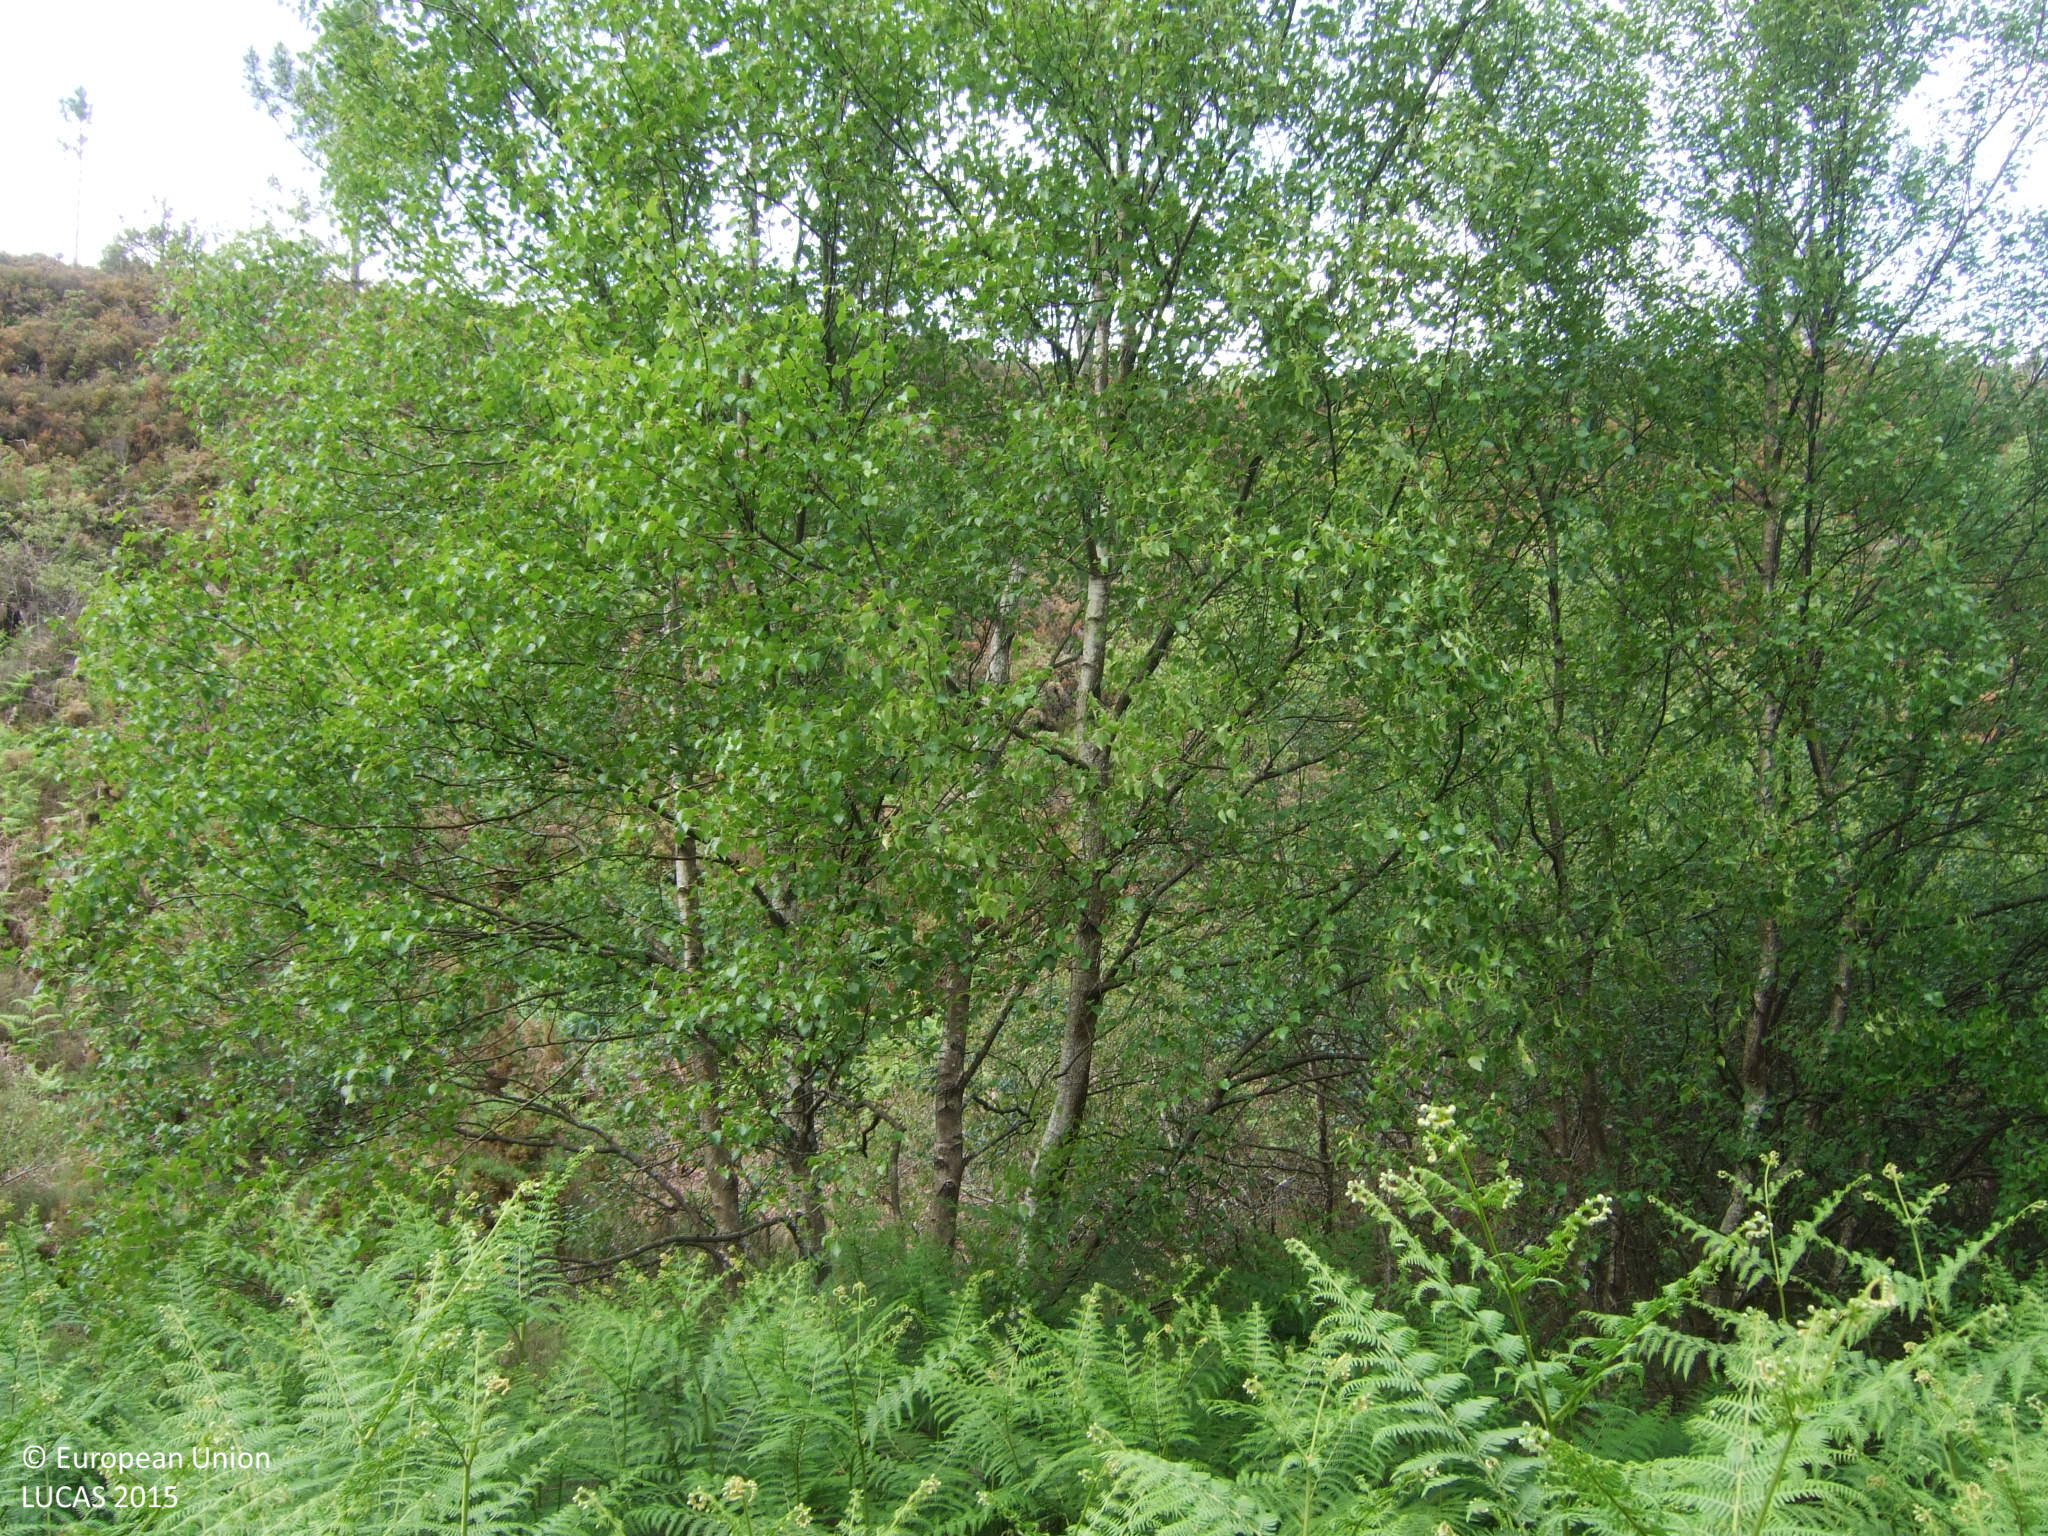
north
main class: Woodland
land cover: Broadleaved woodland
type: acidophilous oak and oak-birch forest
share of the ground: 10 - 25 %
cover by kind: shrubs 75 %, broadleaved forest trees 25 %
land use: Forestry
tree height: > 5 m
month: June
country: ES
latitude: 43.3636
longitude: -7.7197
